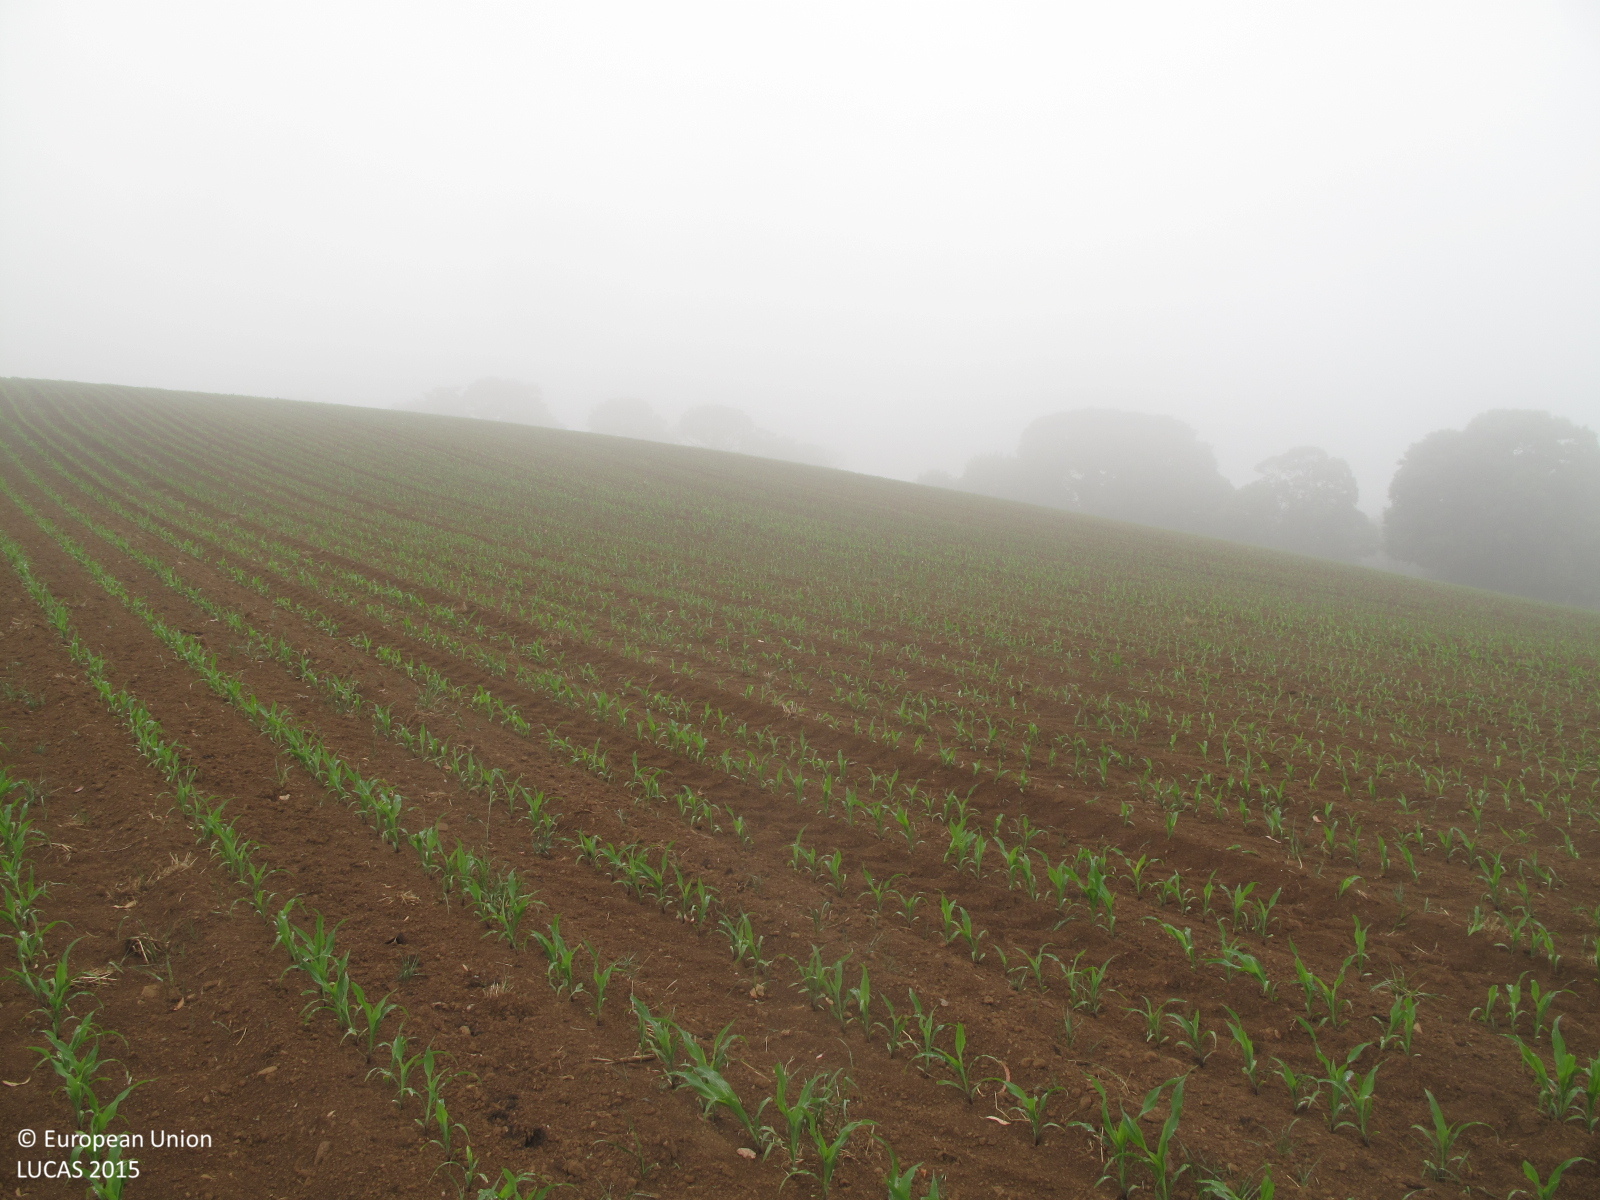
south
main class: Cropland
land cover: Maize
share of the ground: < 10 %
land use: Agriculture (excluding fallow land and kitchen gardens)
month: June
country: ES
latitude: 43.1294
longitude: -8.2046
